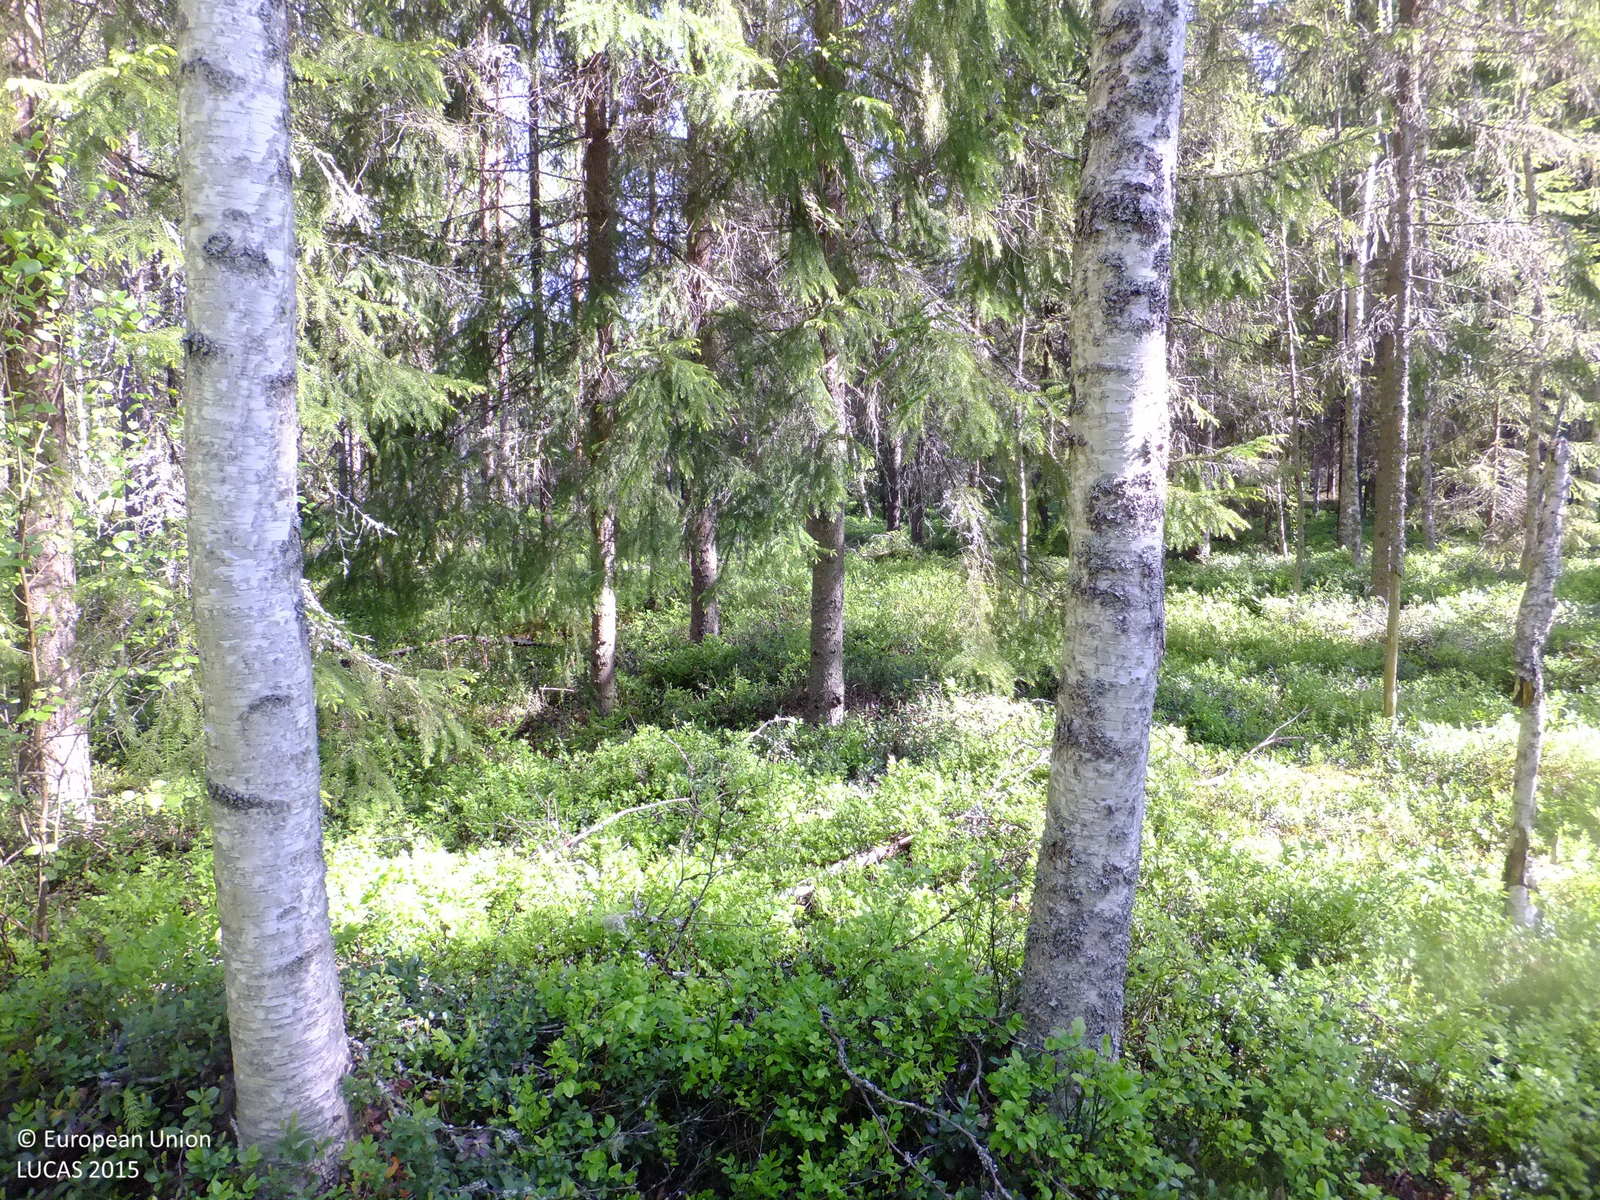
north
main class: Woodland
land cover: Other mixed woodland
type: boreal forest
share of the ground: > 75 %
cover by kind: coniferous forest trees 45 %, broadleaved forest trees 30 %, shrubs 20 %, lichens and mosses 5 %
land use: Forestry
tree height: > 5 m
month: June
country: FI
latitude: 63.6125
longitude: 22.8981
